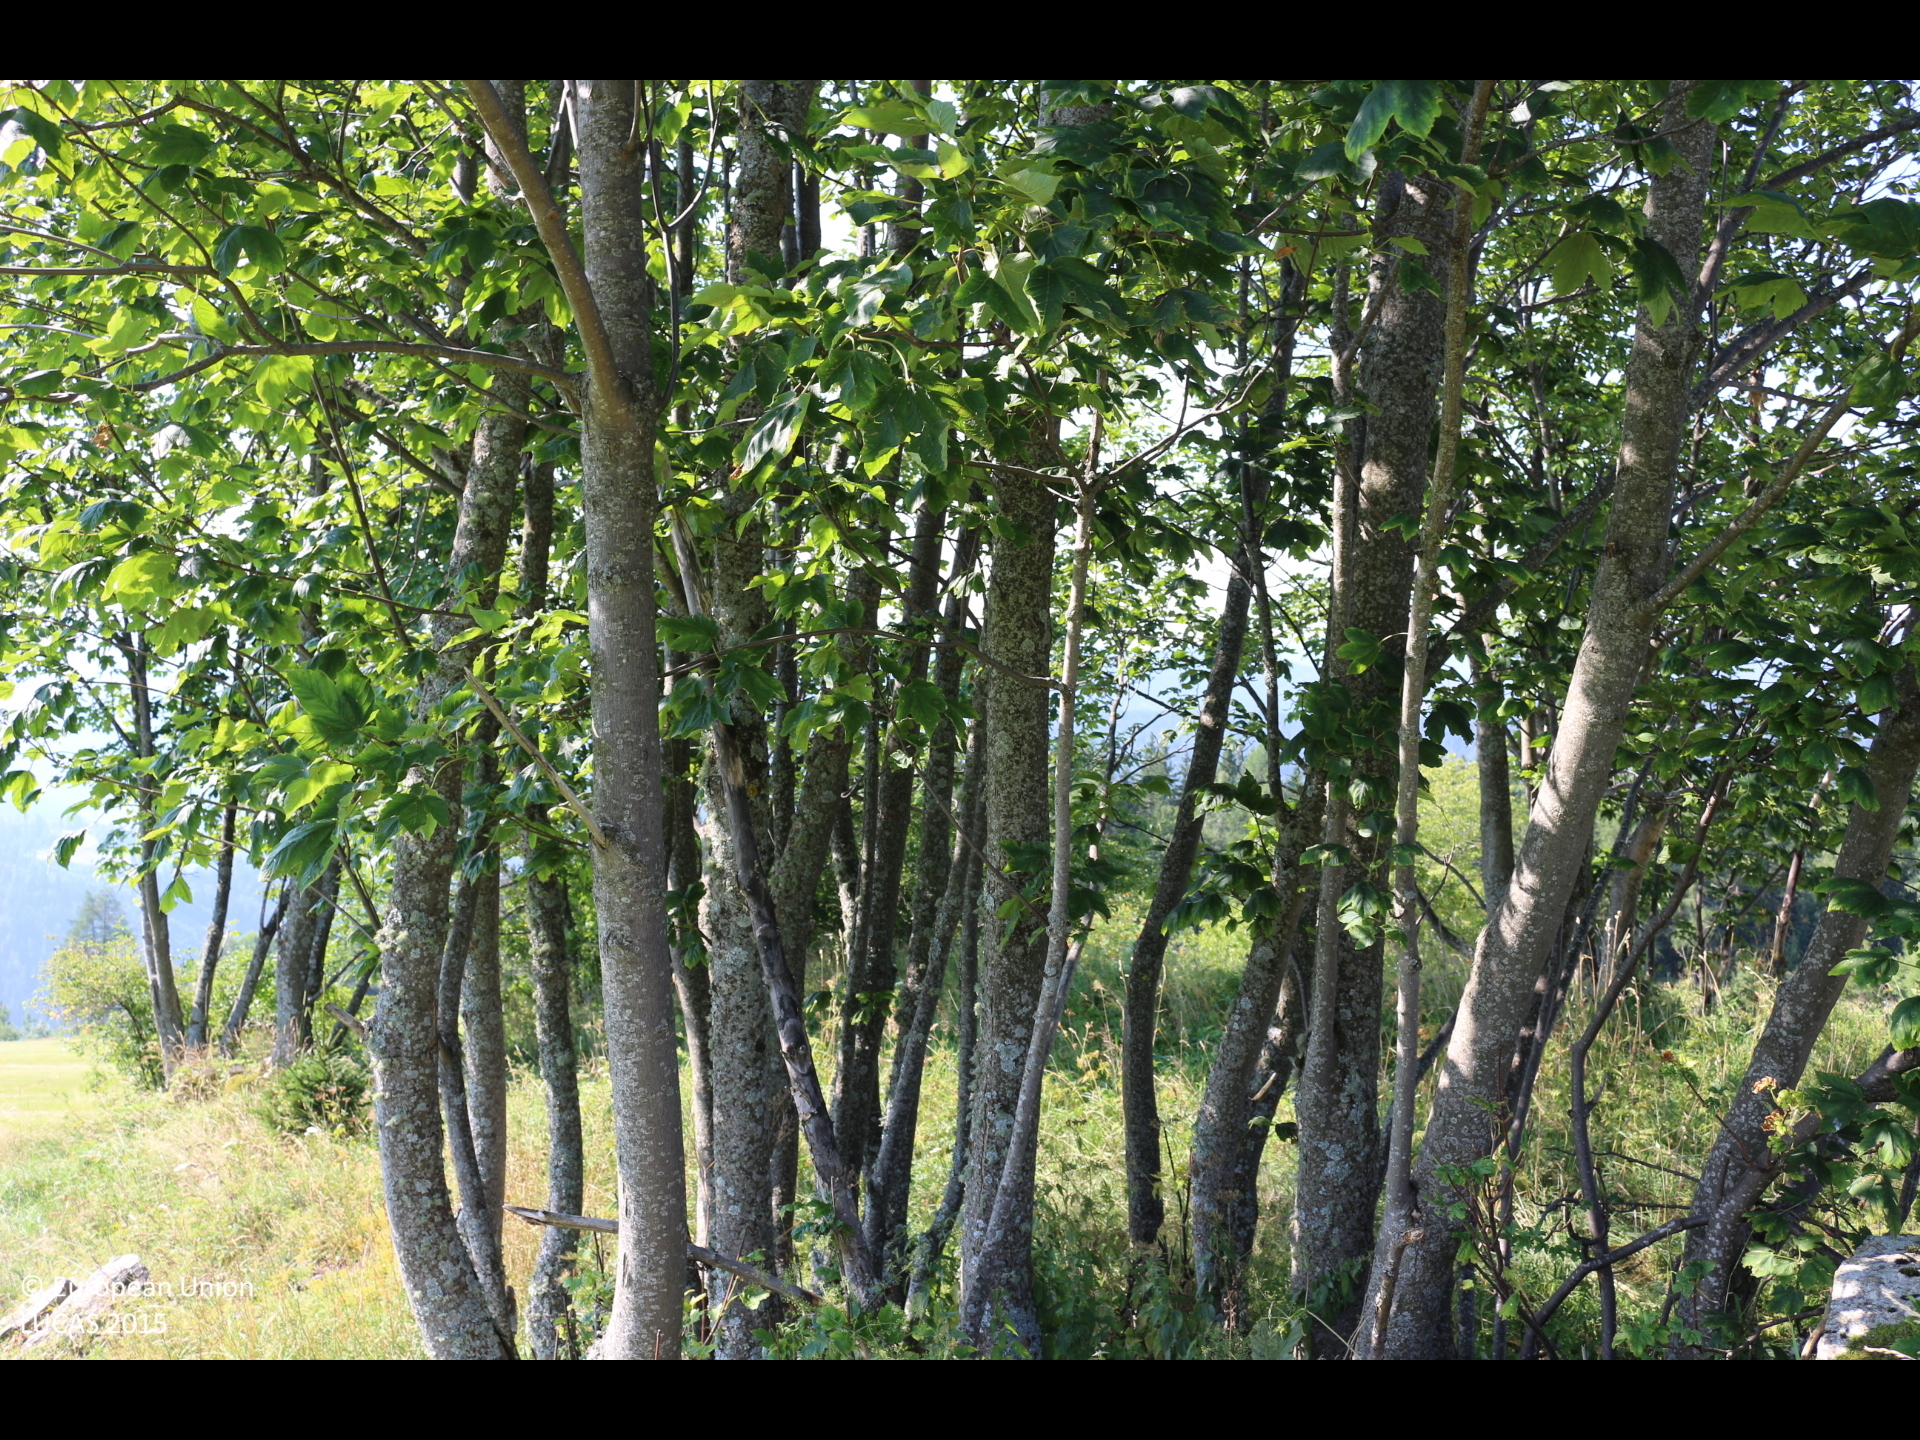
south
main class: Woodland
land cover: Broadleaved woodland
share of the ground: 50 - 75 %
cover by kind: broadleaved forest trees 70 %, herbaceous plants 25 %, consolidated bare surface 5 %
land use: Agriculture (excluding fallow land and kitchen gardens)
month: August
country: AT
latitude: 46.8875
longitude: 14.0530
